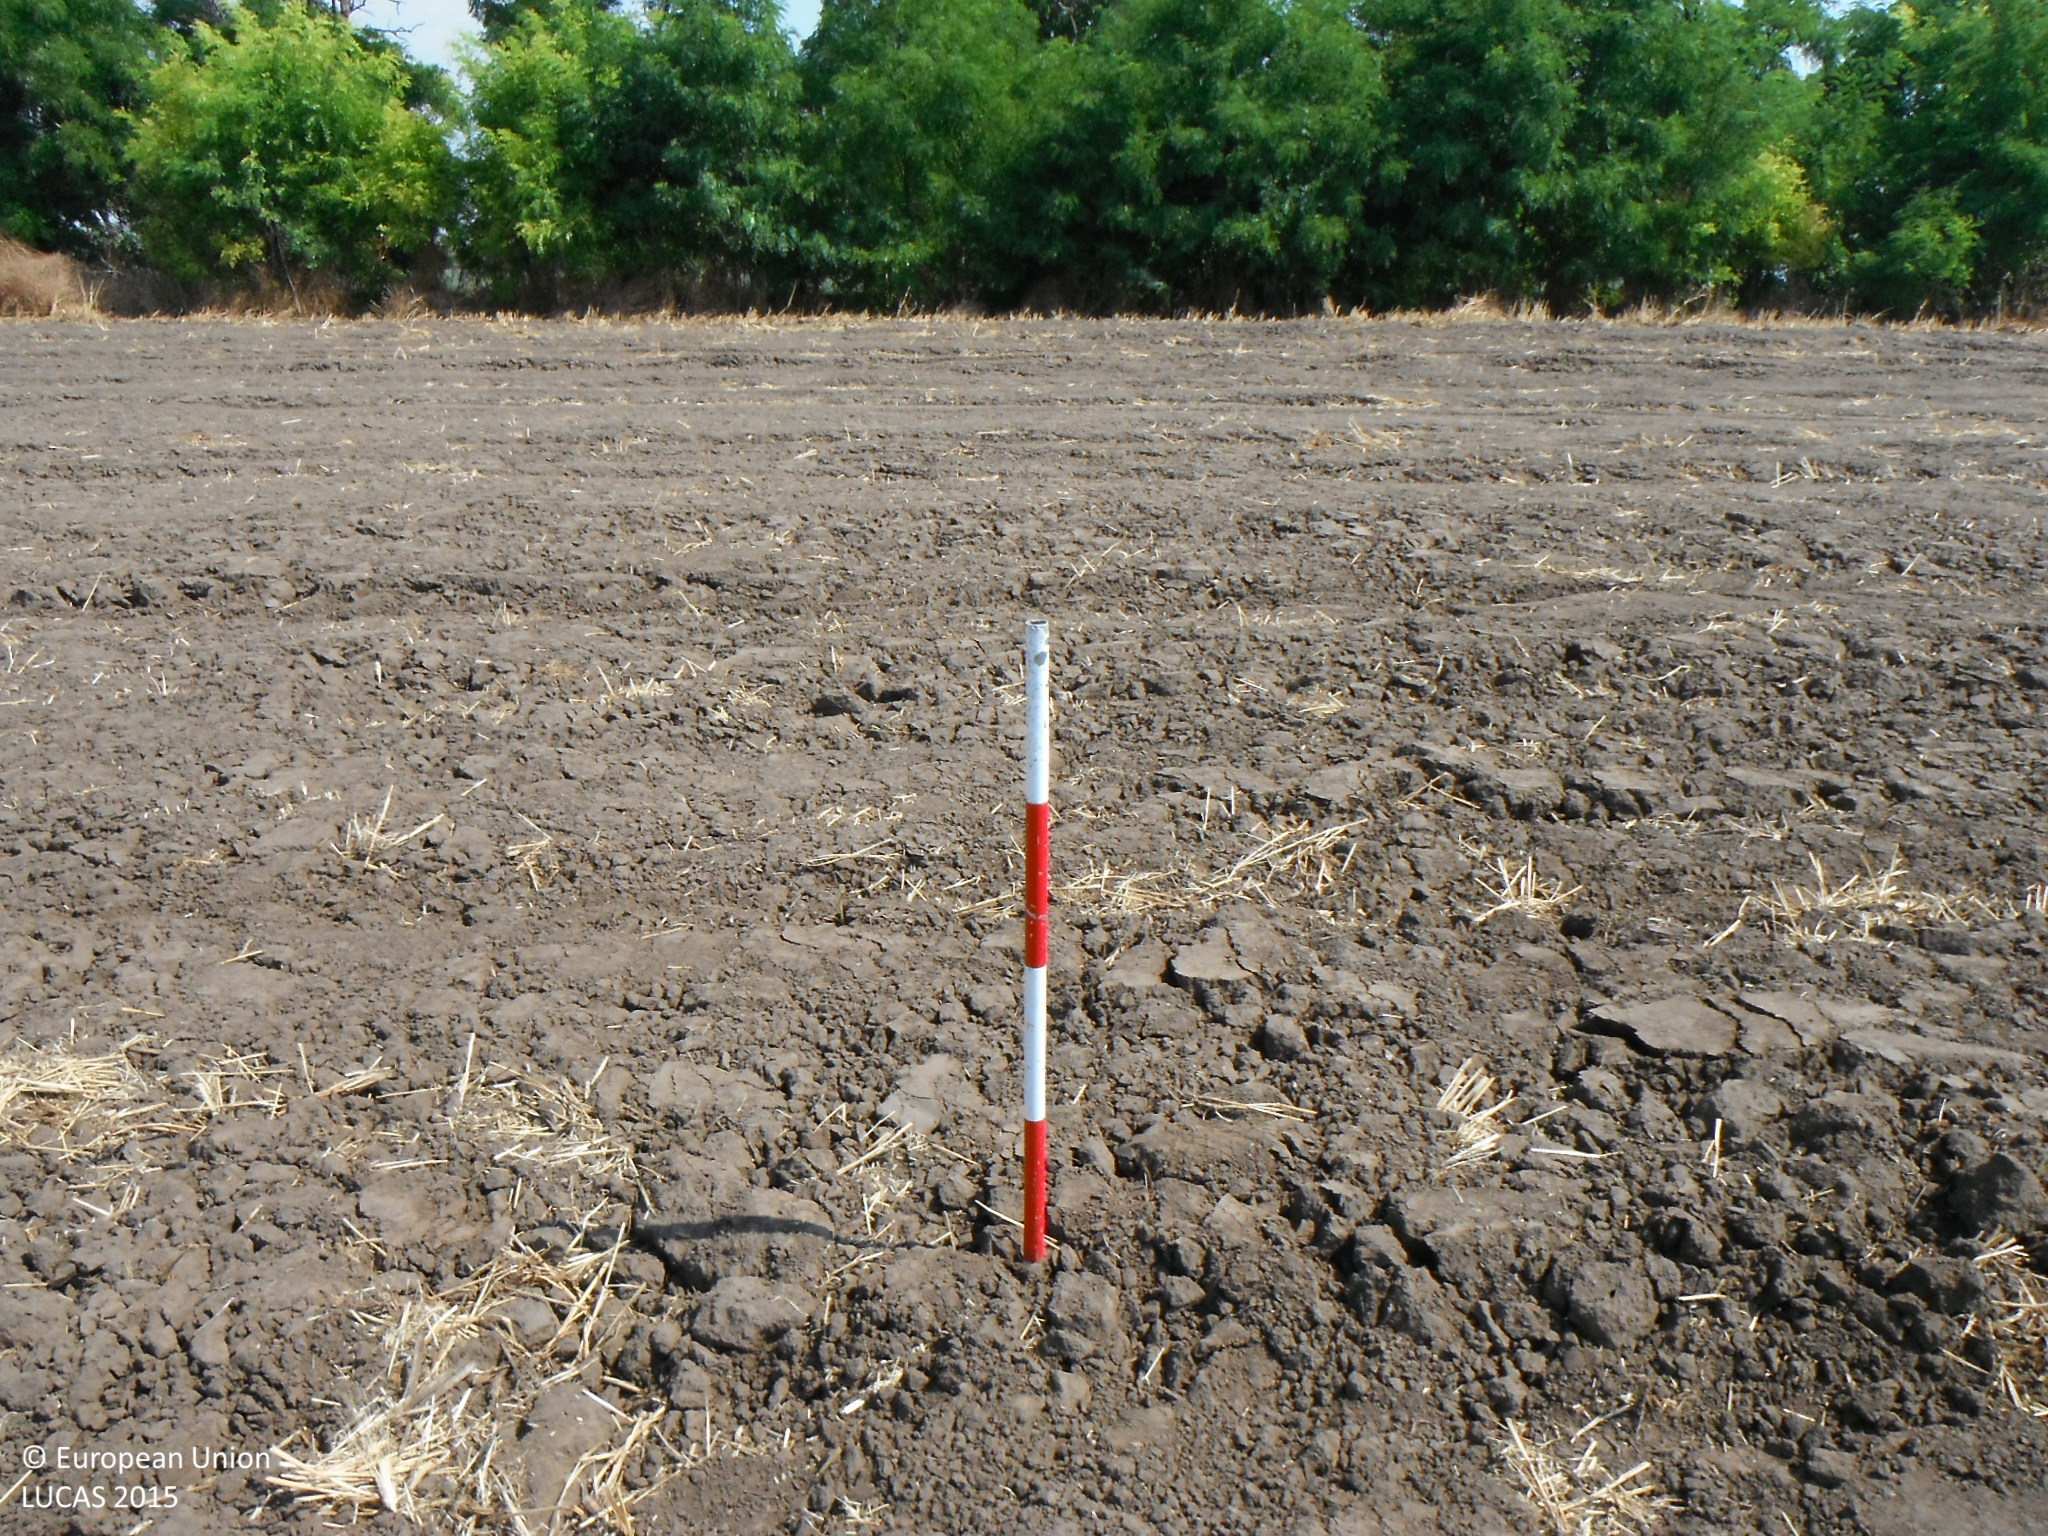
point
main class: Cropland
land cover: Common wheat
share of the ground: < 10 %
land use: Agriculture (excluding fallow land and kitchen gardens)
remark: Harvested field
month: August
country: SK
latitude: 48.0079
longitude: 18.2038
